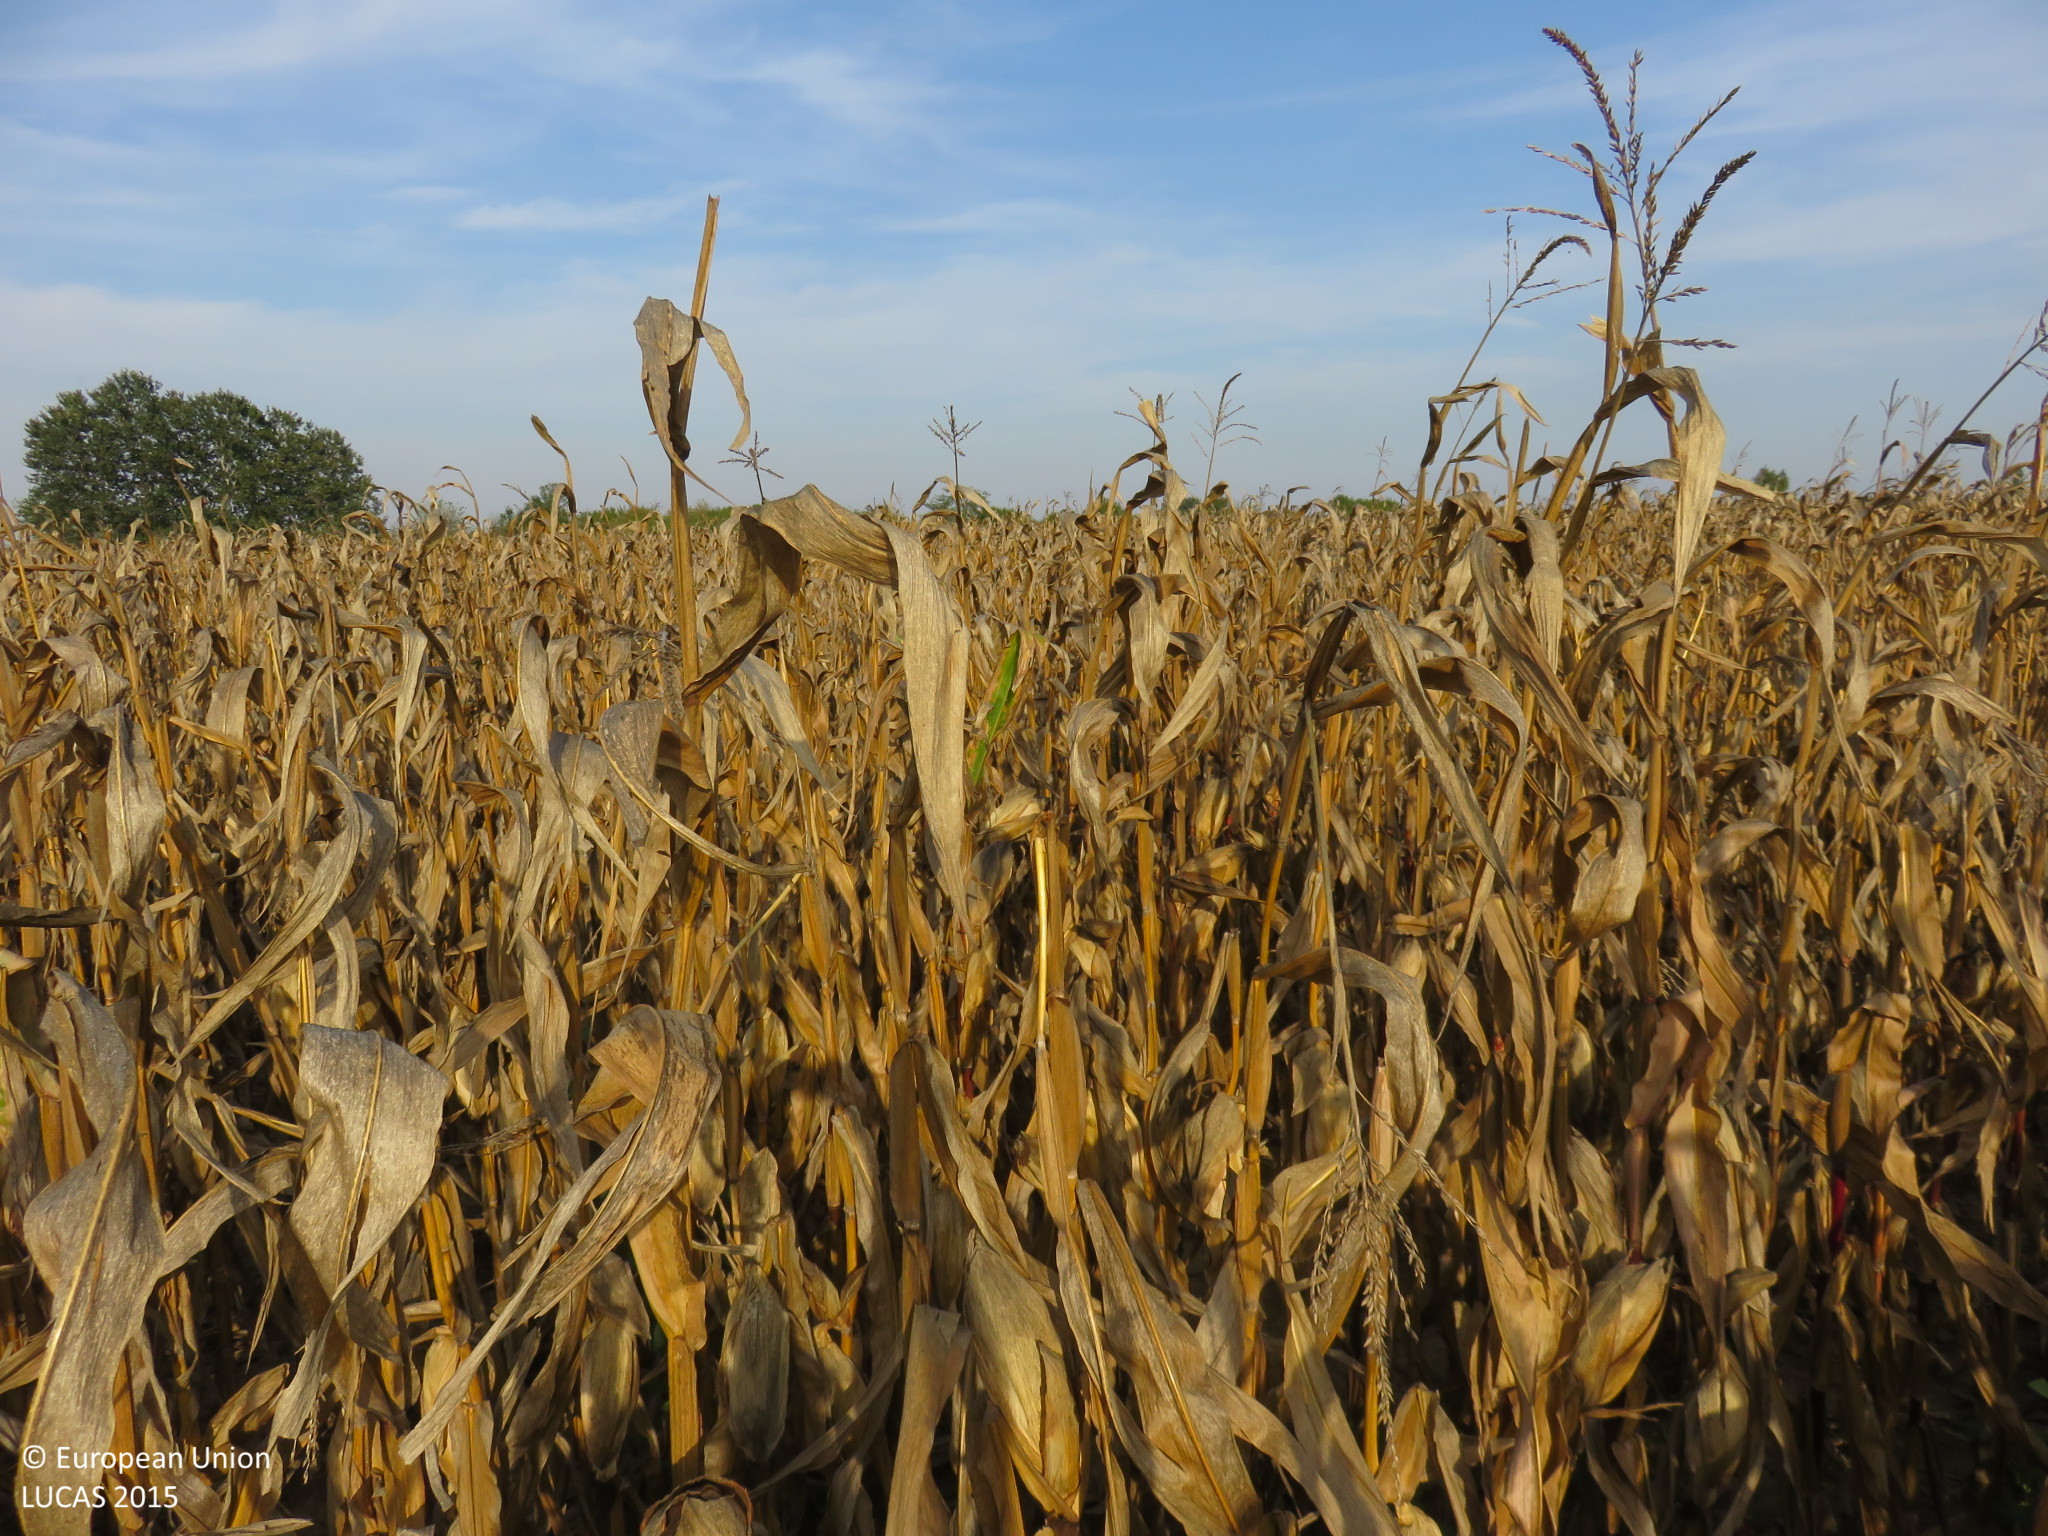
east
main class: Cropland
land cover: Maize
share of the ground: > 75 %
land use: Agriculture (excluding fallow land and kitchen gardens)
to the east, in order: Maize; Grass margins; Tracks; Grass margins; Shrubland with sparse tree cover; Ditches and canals; Shrubland with sparse tree cover; Tracks; Grass margins; Other bare soil
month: September
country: BG
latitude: 43.7282
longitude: 24.5018
